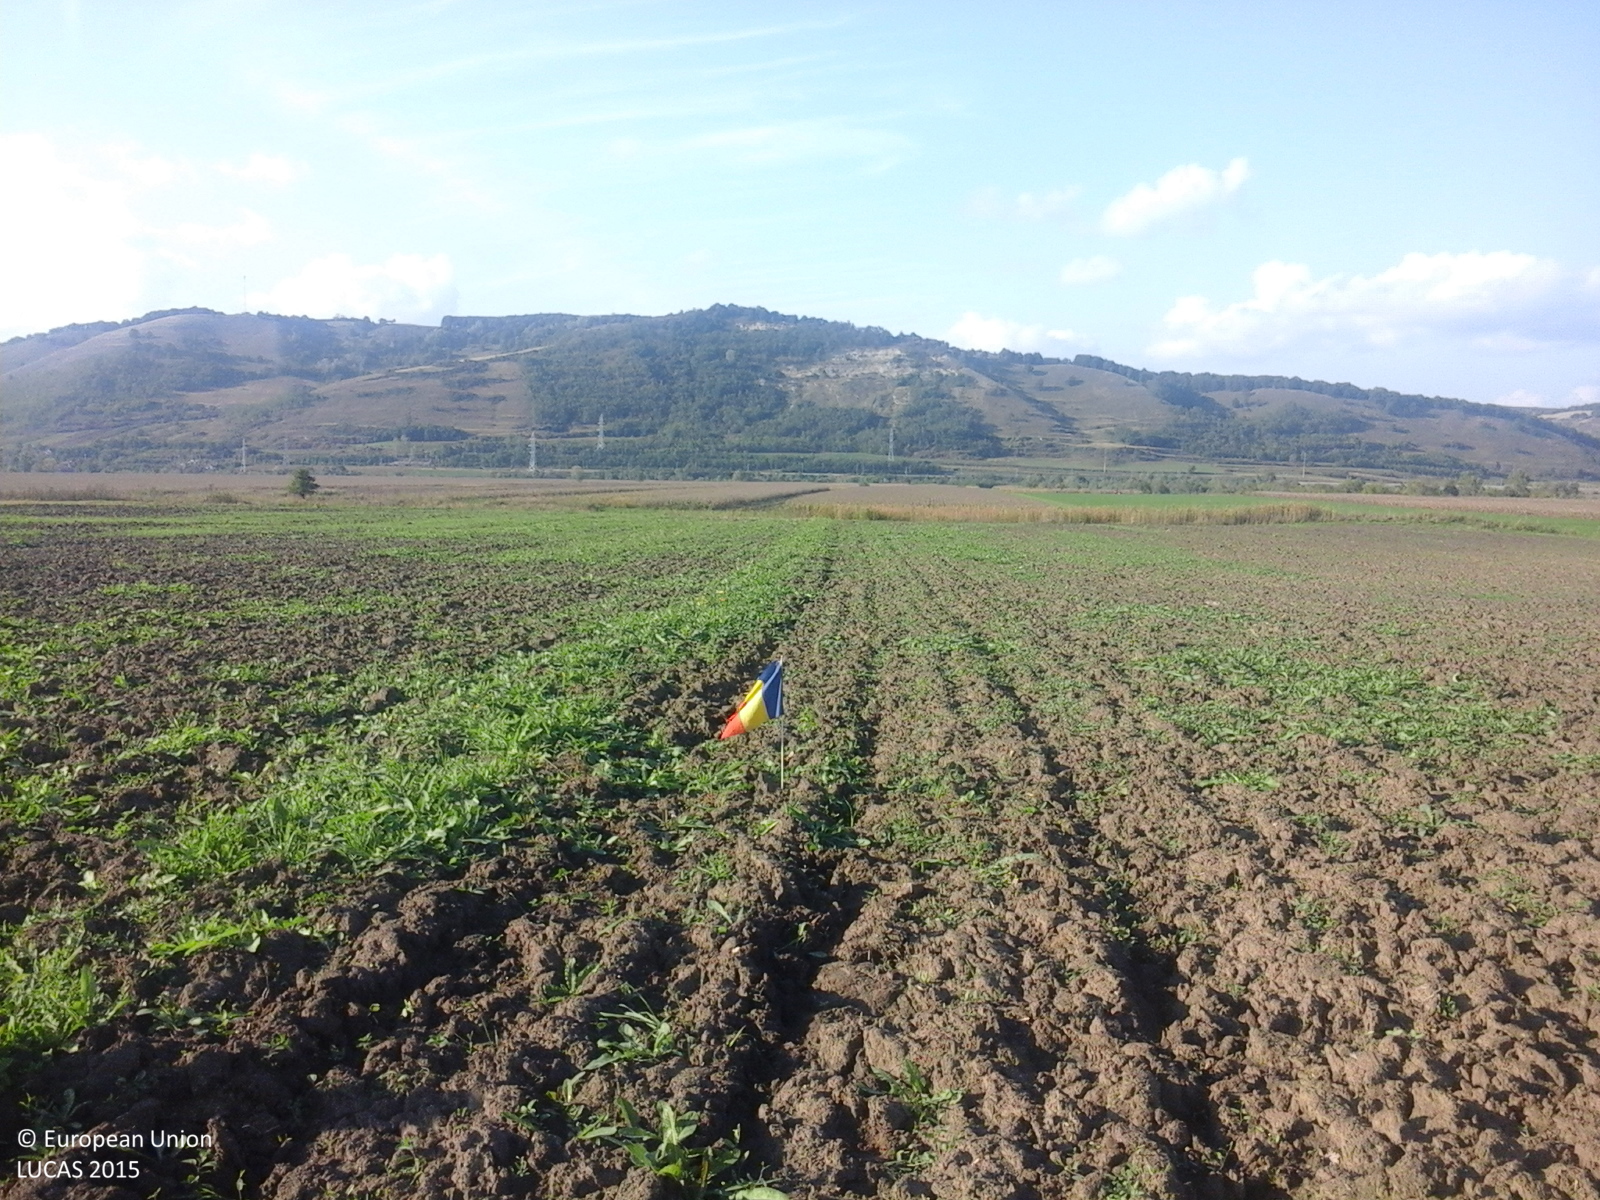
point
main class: Grassland
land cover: Spontaneously vegetated surfaces
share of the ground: > 75 %
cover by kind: herbaceous plants 100 %
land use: Agriculture (excluding fallow land and kitchen gardens)
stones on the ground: < 10 %
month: October
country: RO
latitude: 46.0831
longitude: 24.1335
